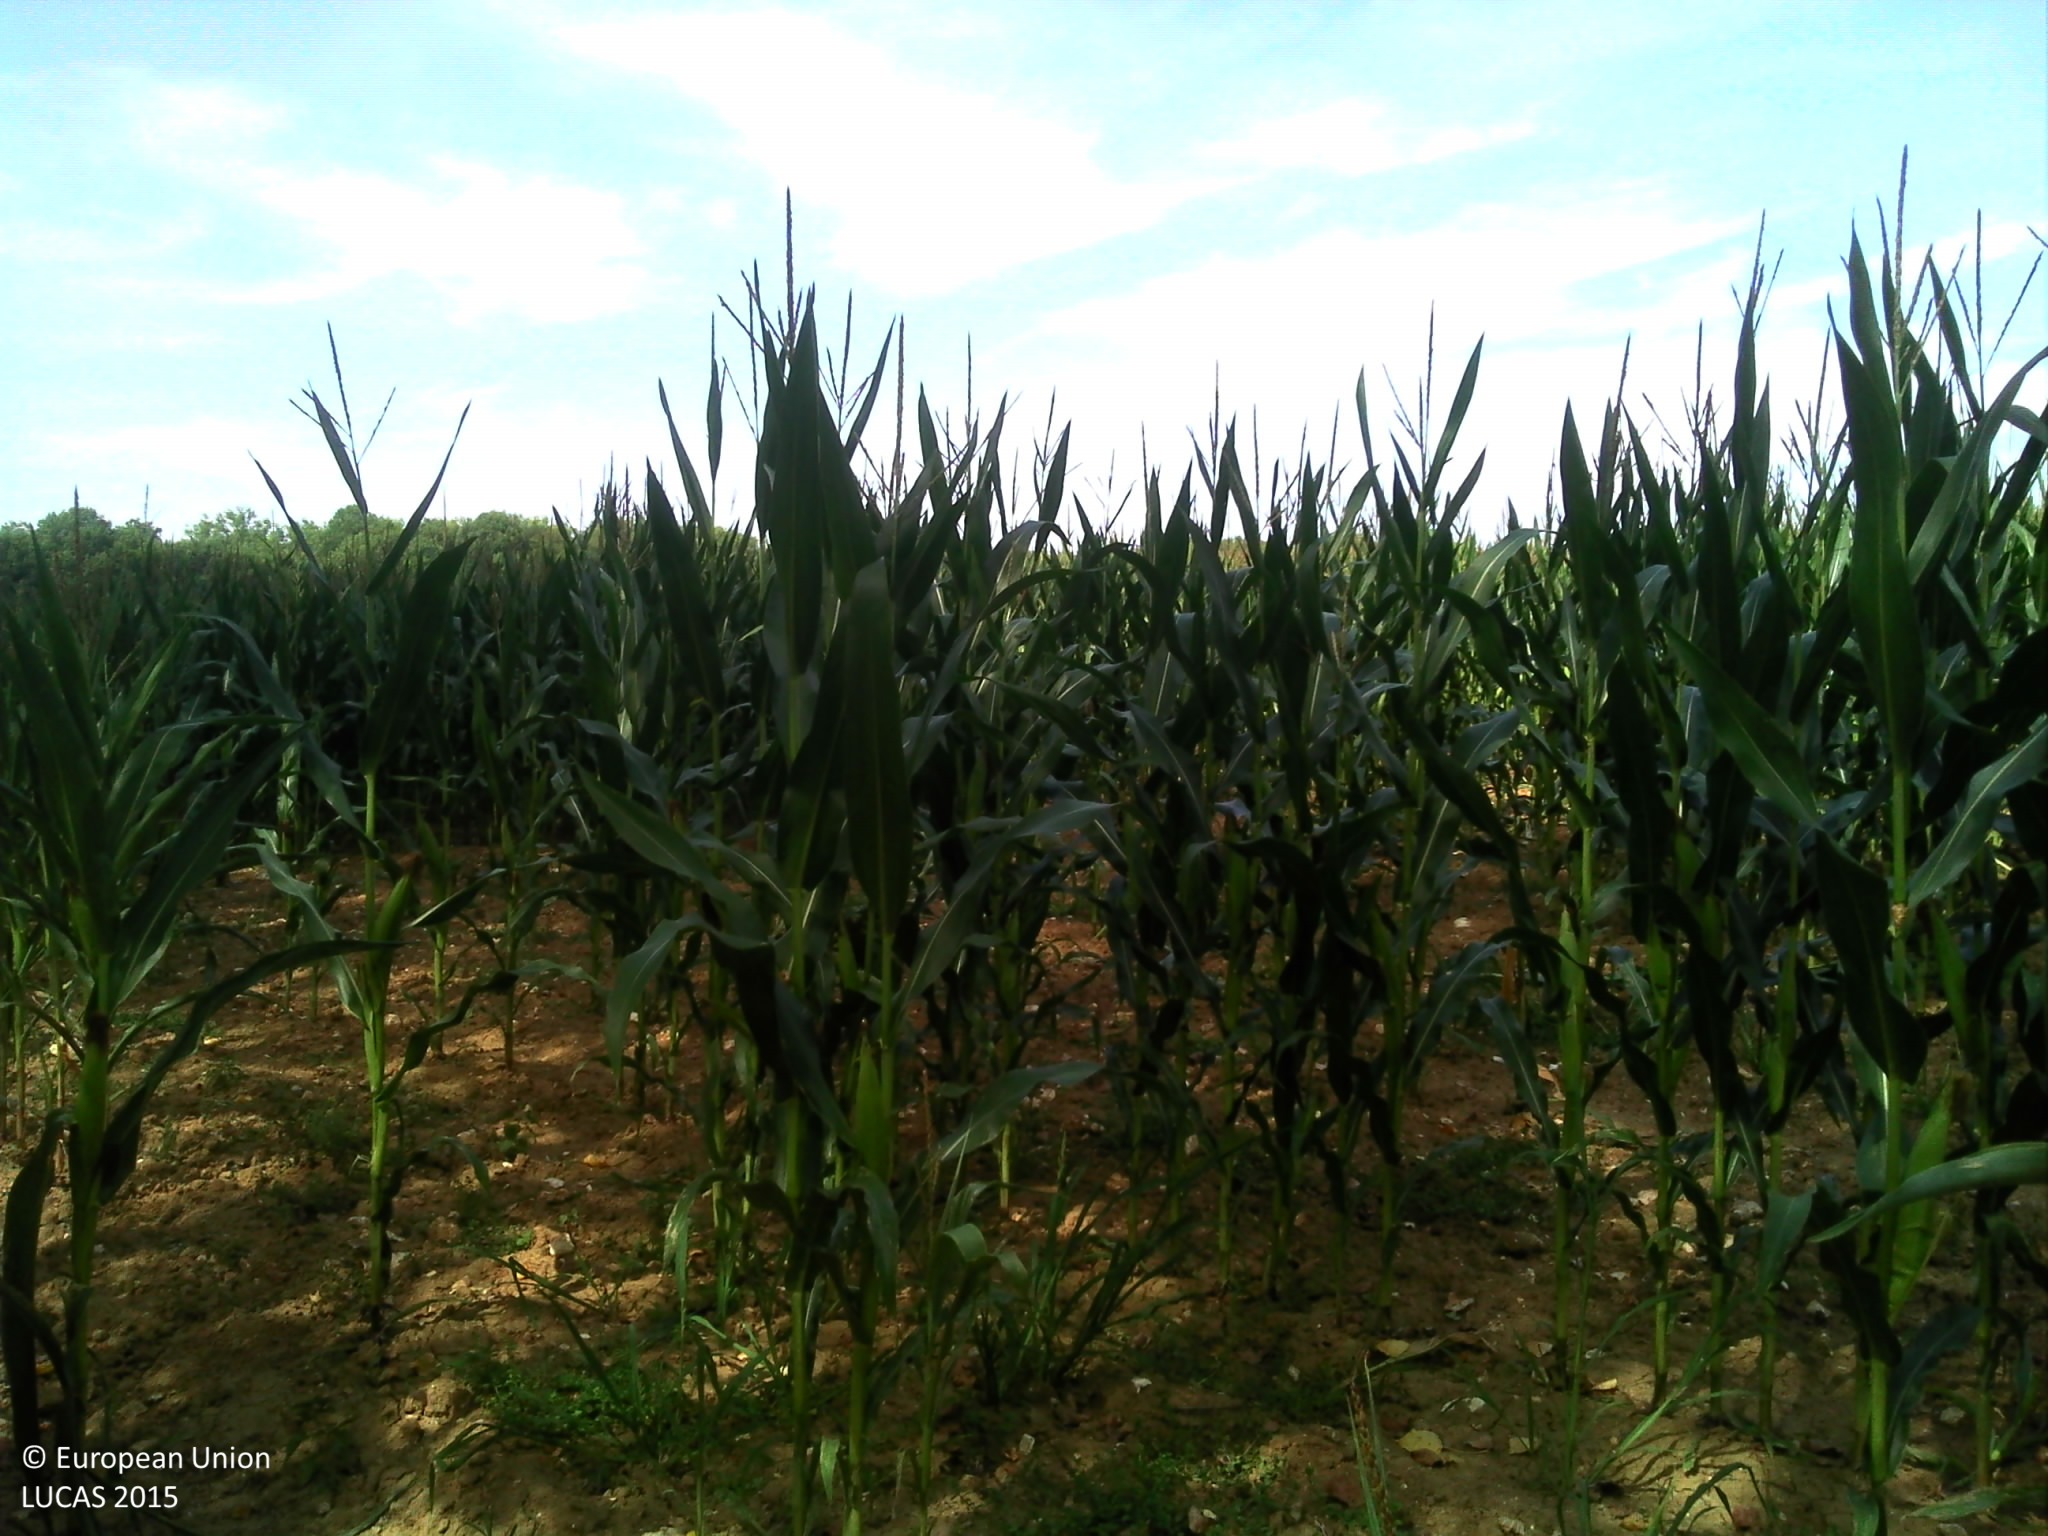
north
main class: Woodland
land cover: Broadleaved woodland
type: exotic forest
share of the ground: > 75 %
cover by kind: broadleaved forest trees 55 %, herbaceous plants 15 %, lichens and mosses 15 %, unconsolidated bare surface 5 %
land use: Forestry
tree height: > 5 m
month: August
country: FR
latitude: 48.6890
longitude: 3.3231
